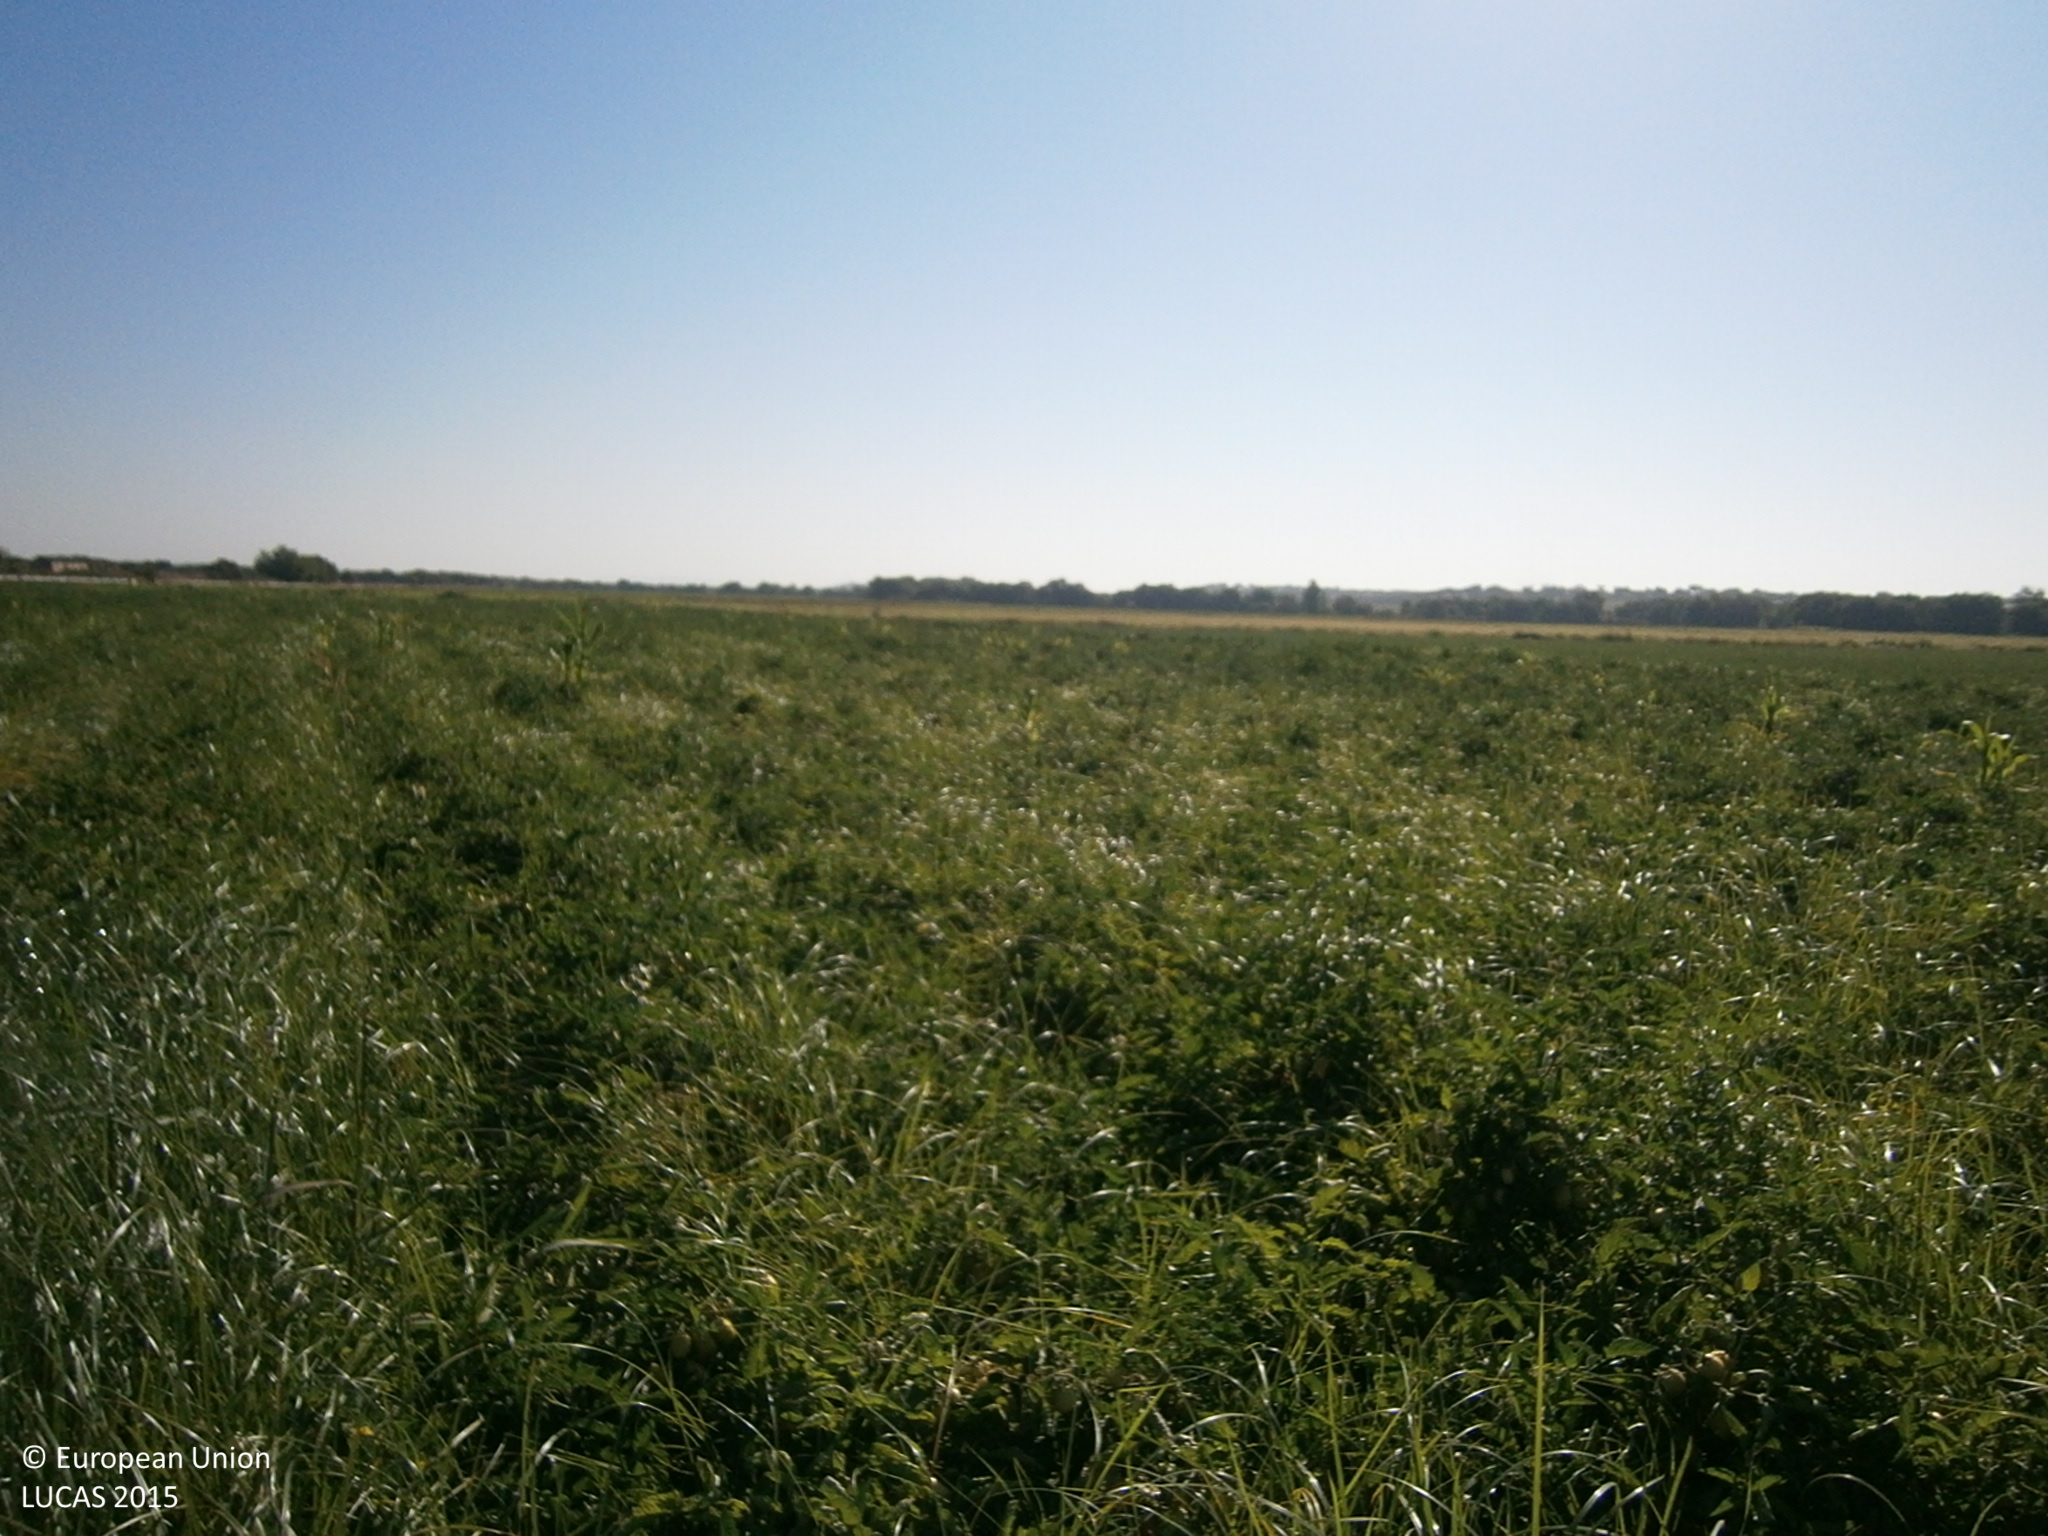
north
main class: Cropland
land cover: Tomatoes
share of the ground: > 75 %
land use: Agriculture (excluding fallow land and kitchen gardens)
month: July
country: ES
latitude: 38.9525
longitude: -6.8109
